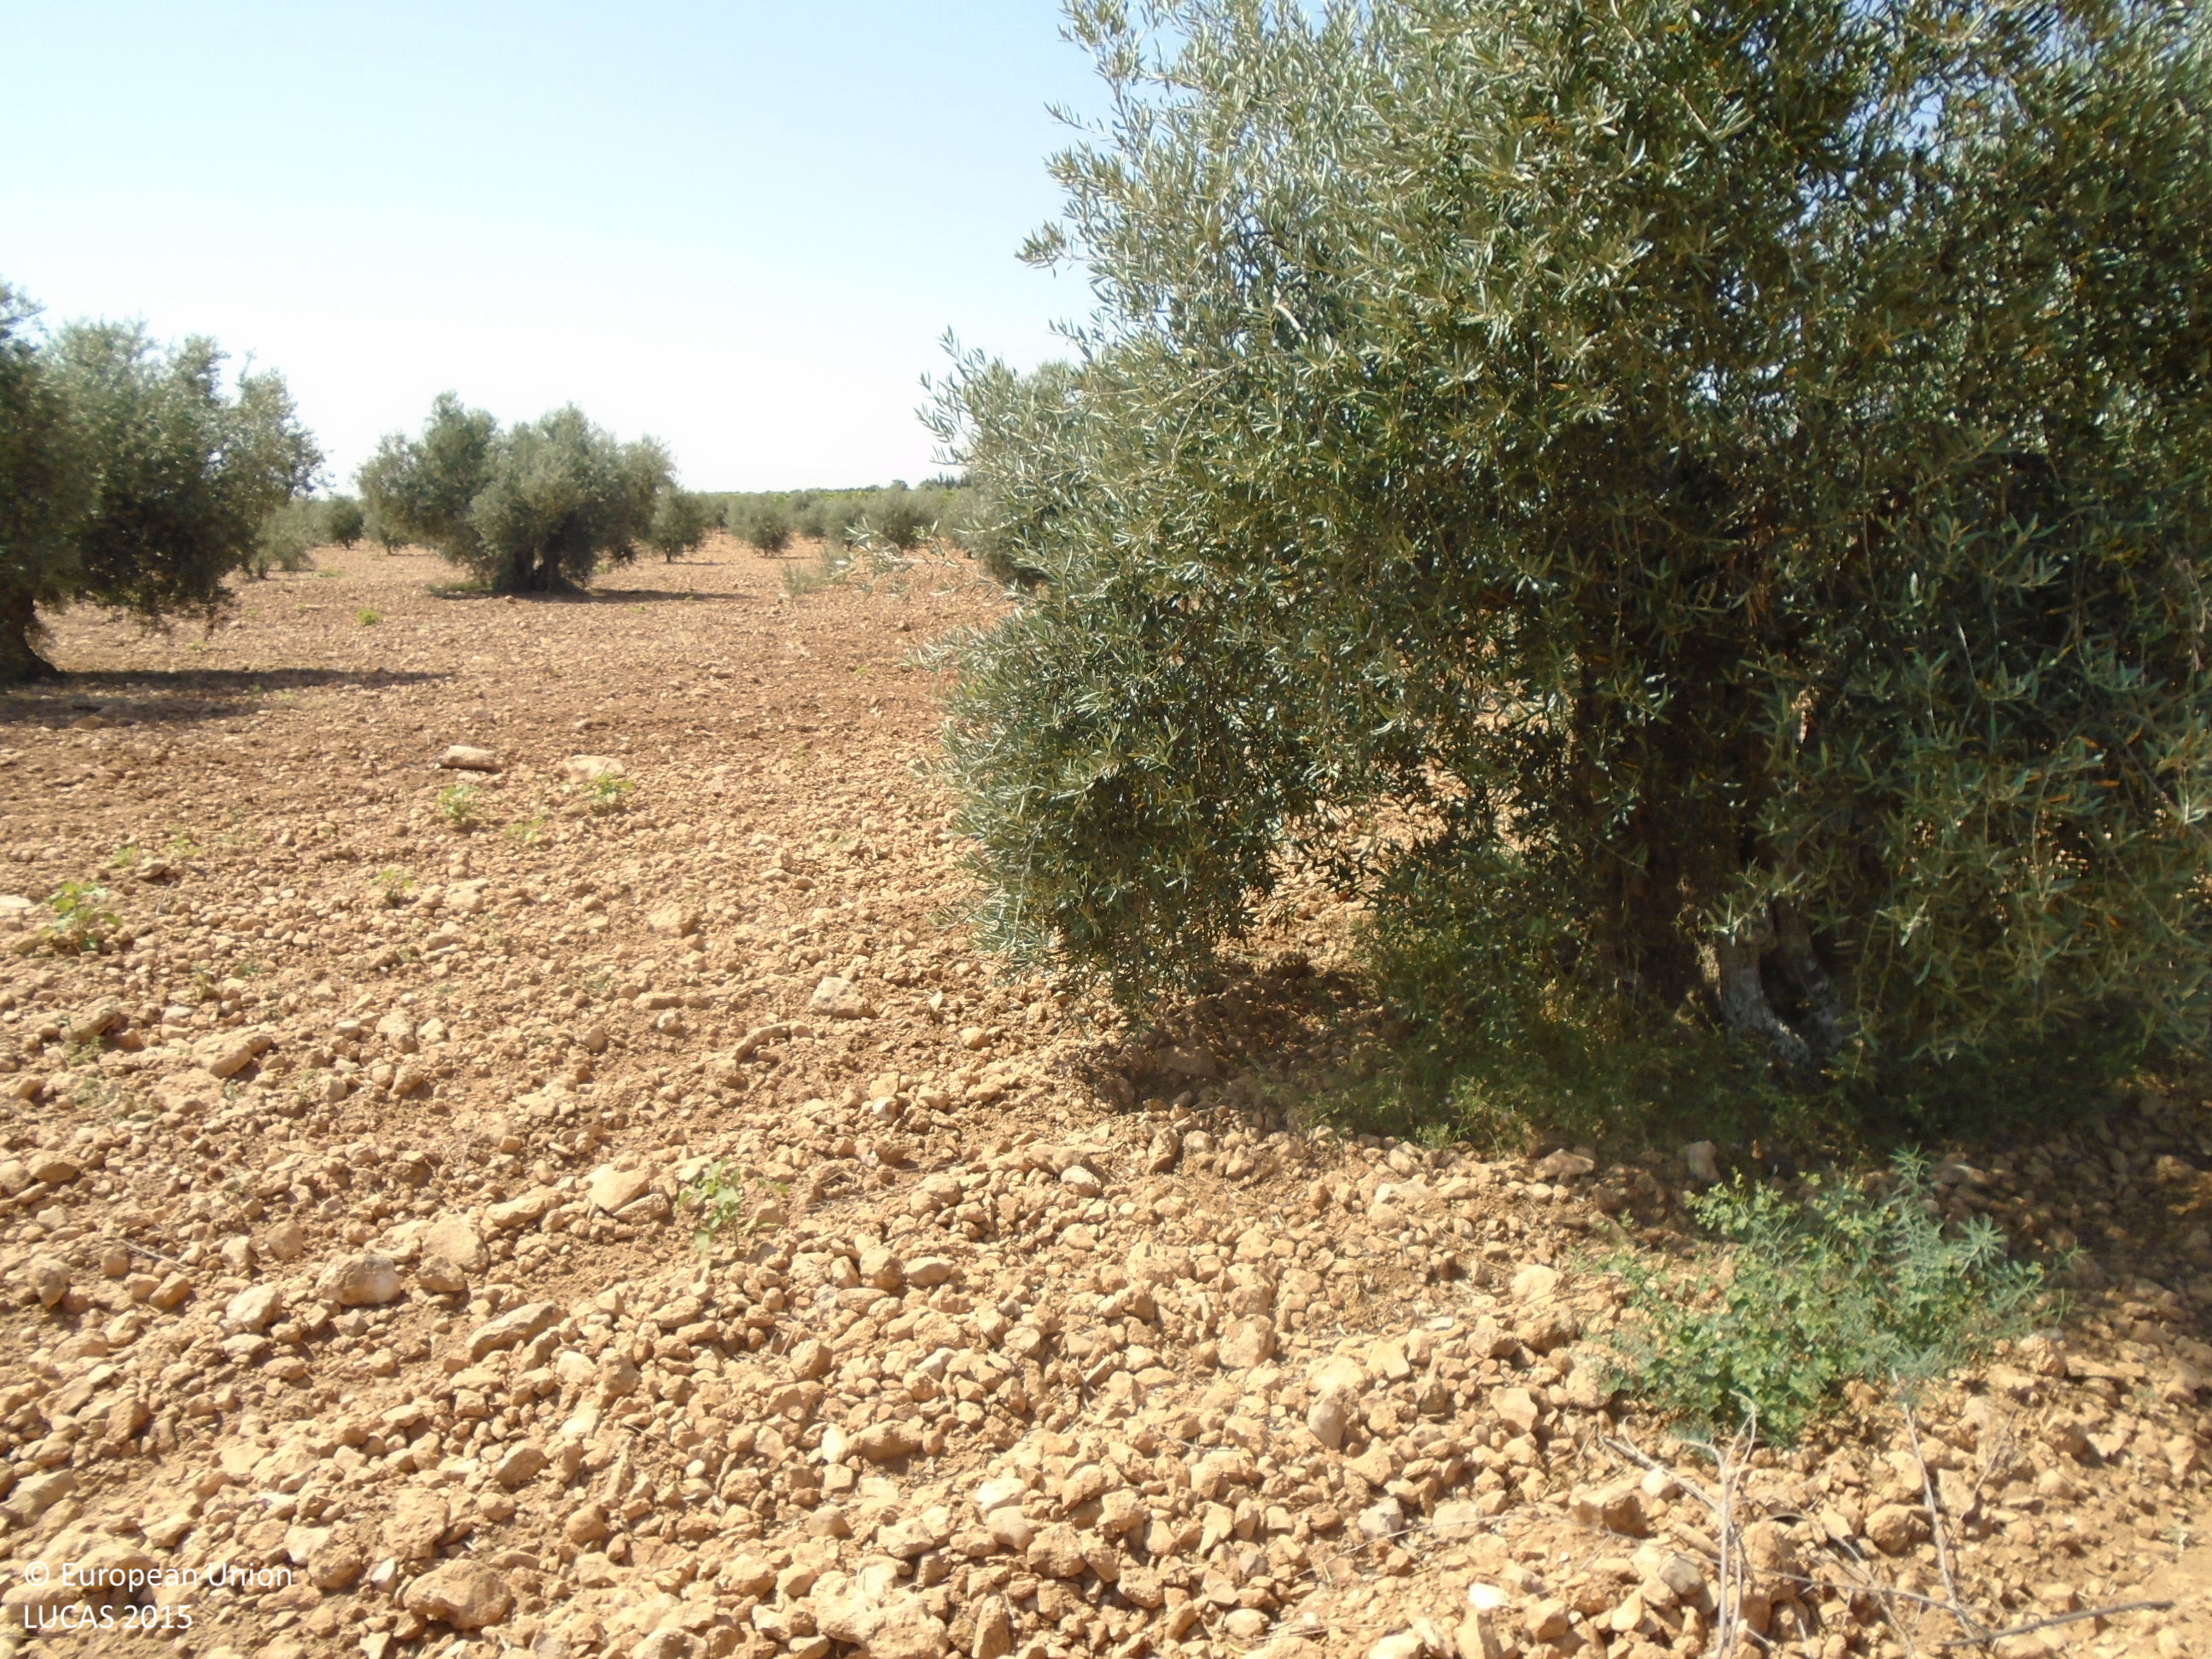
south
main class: Cropland
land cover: Olive groves
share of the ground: 10 - 25 %
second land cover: Other bare soil
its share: > 75 %
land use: Agriculture (excluding fallow land and kitchen gardens)
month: June
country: ES
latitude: 39.1630
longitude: -3.6414
